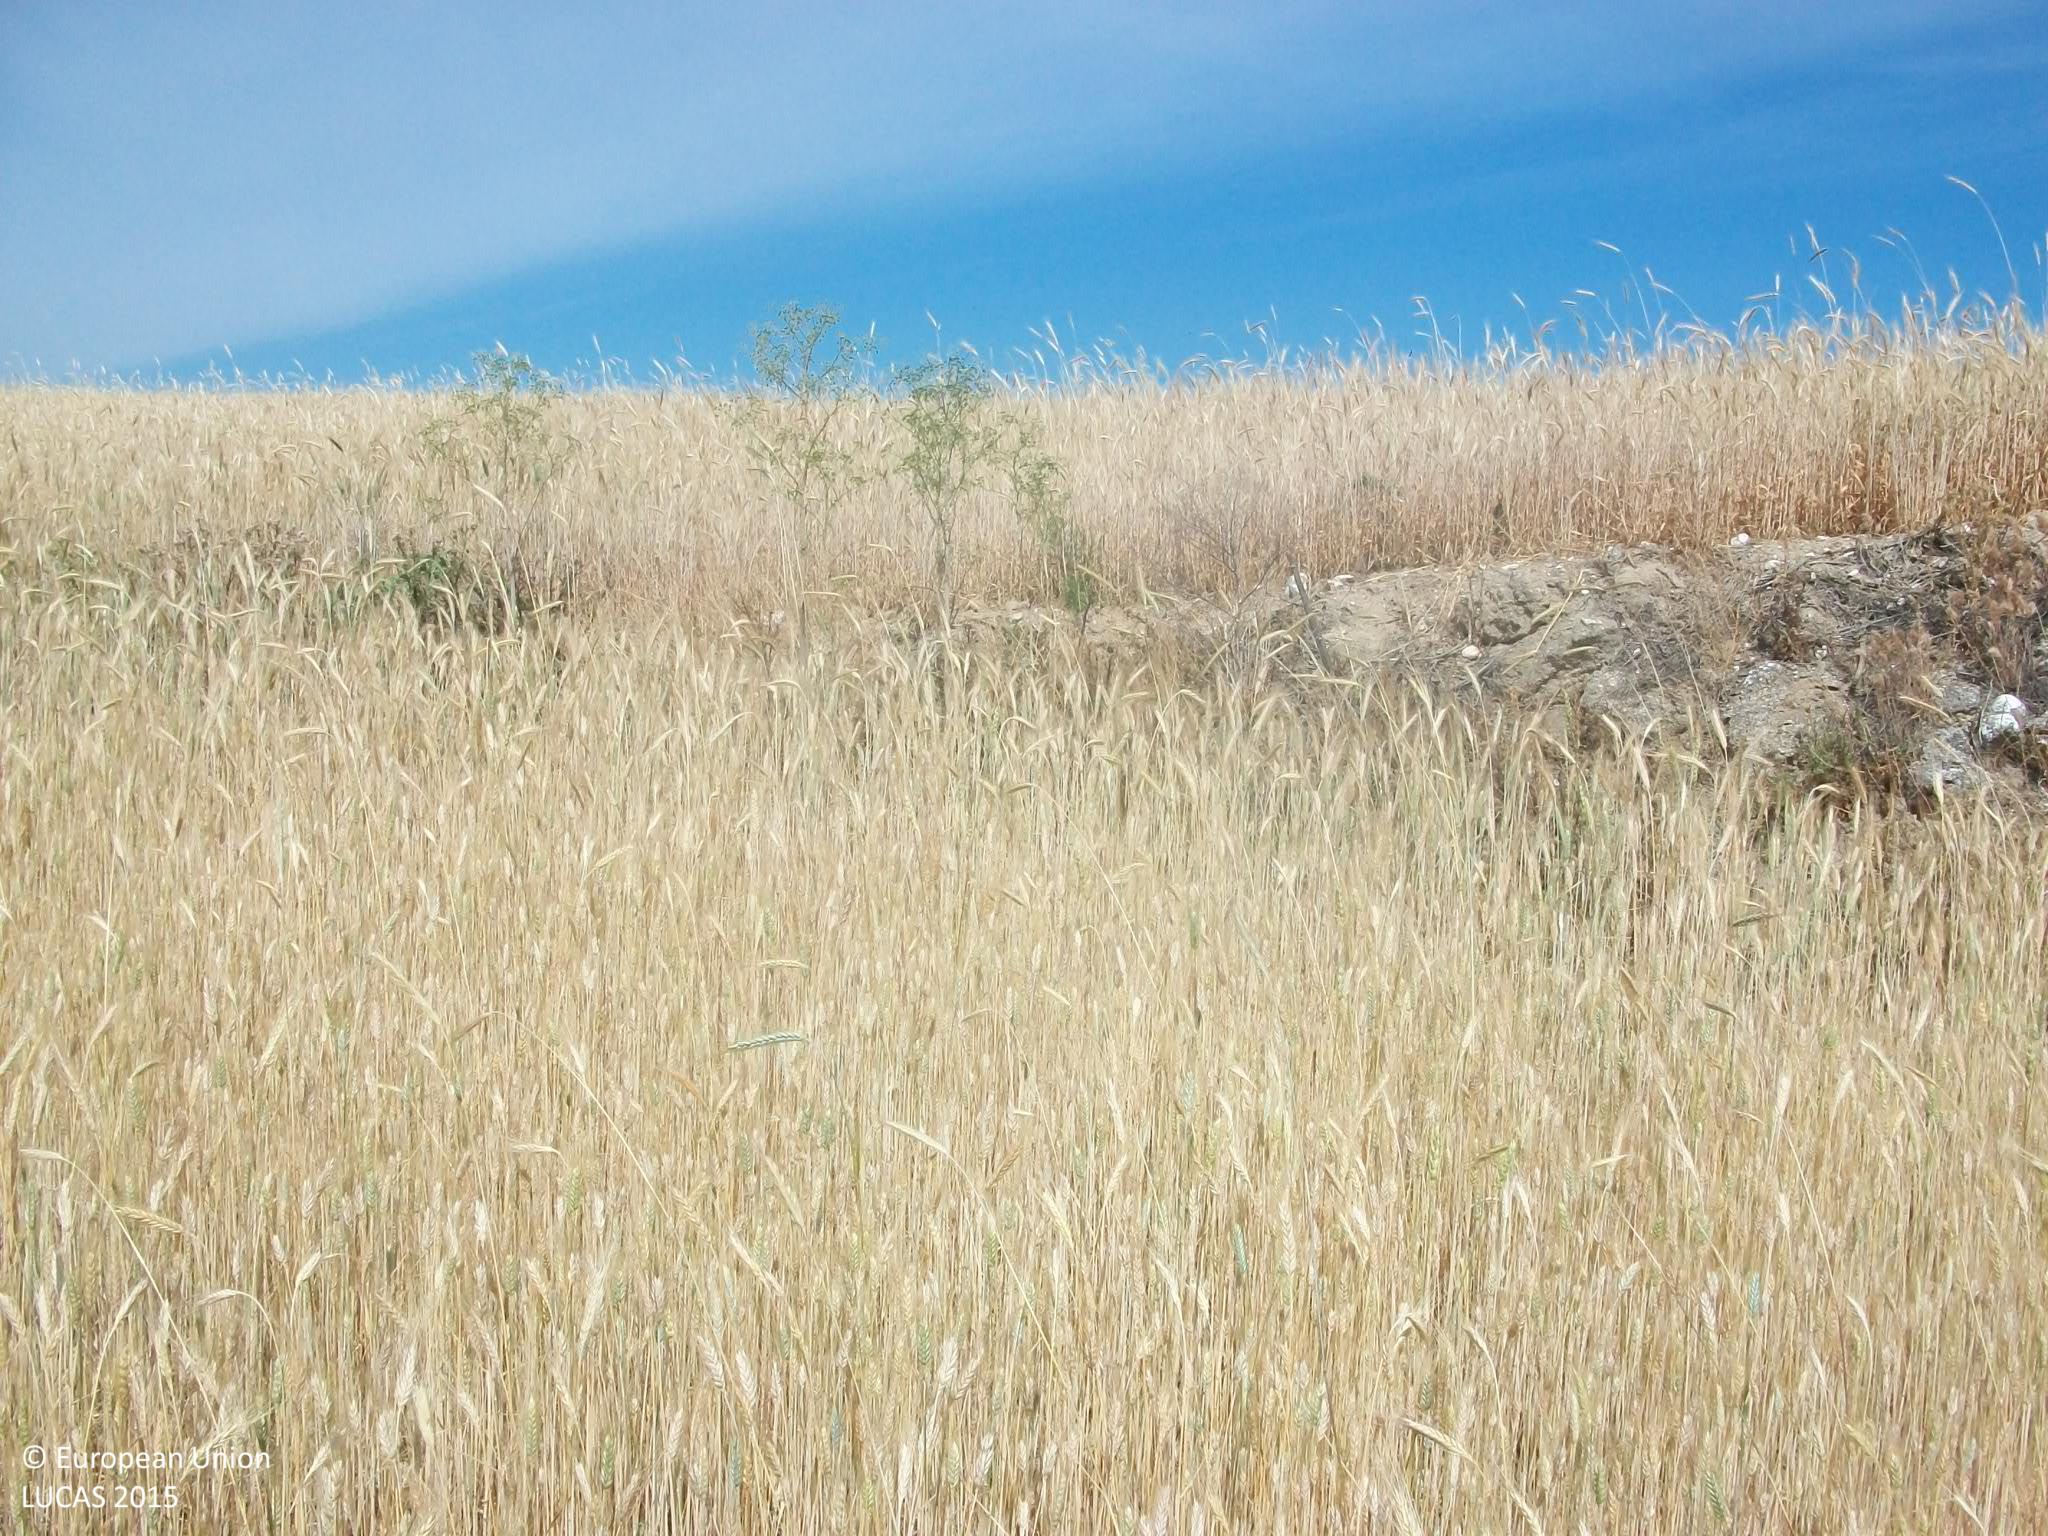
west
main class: Cropland
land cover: Common wheat
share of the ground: > 75 %
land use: Agriculture (excluding fallow land and kitchen gardens)
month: May
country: ES
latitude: 40.0539
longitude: -3.6893
